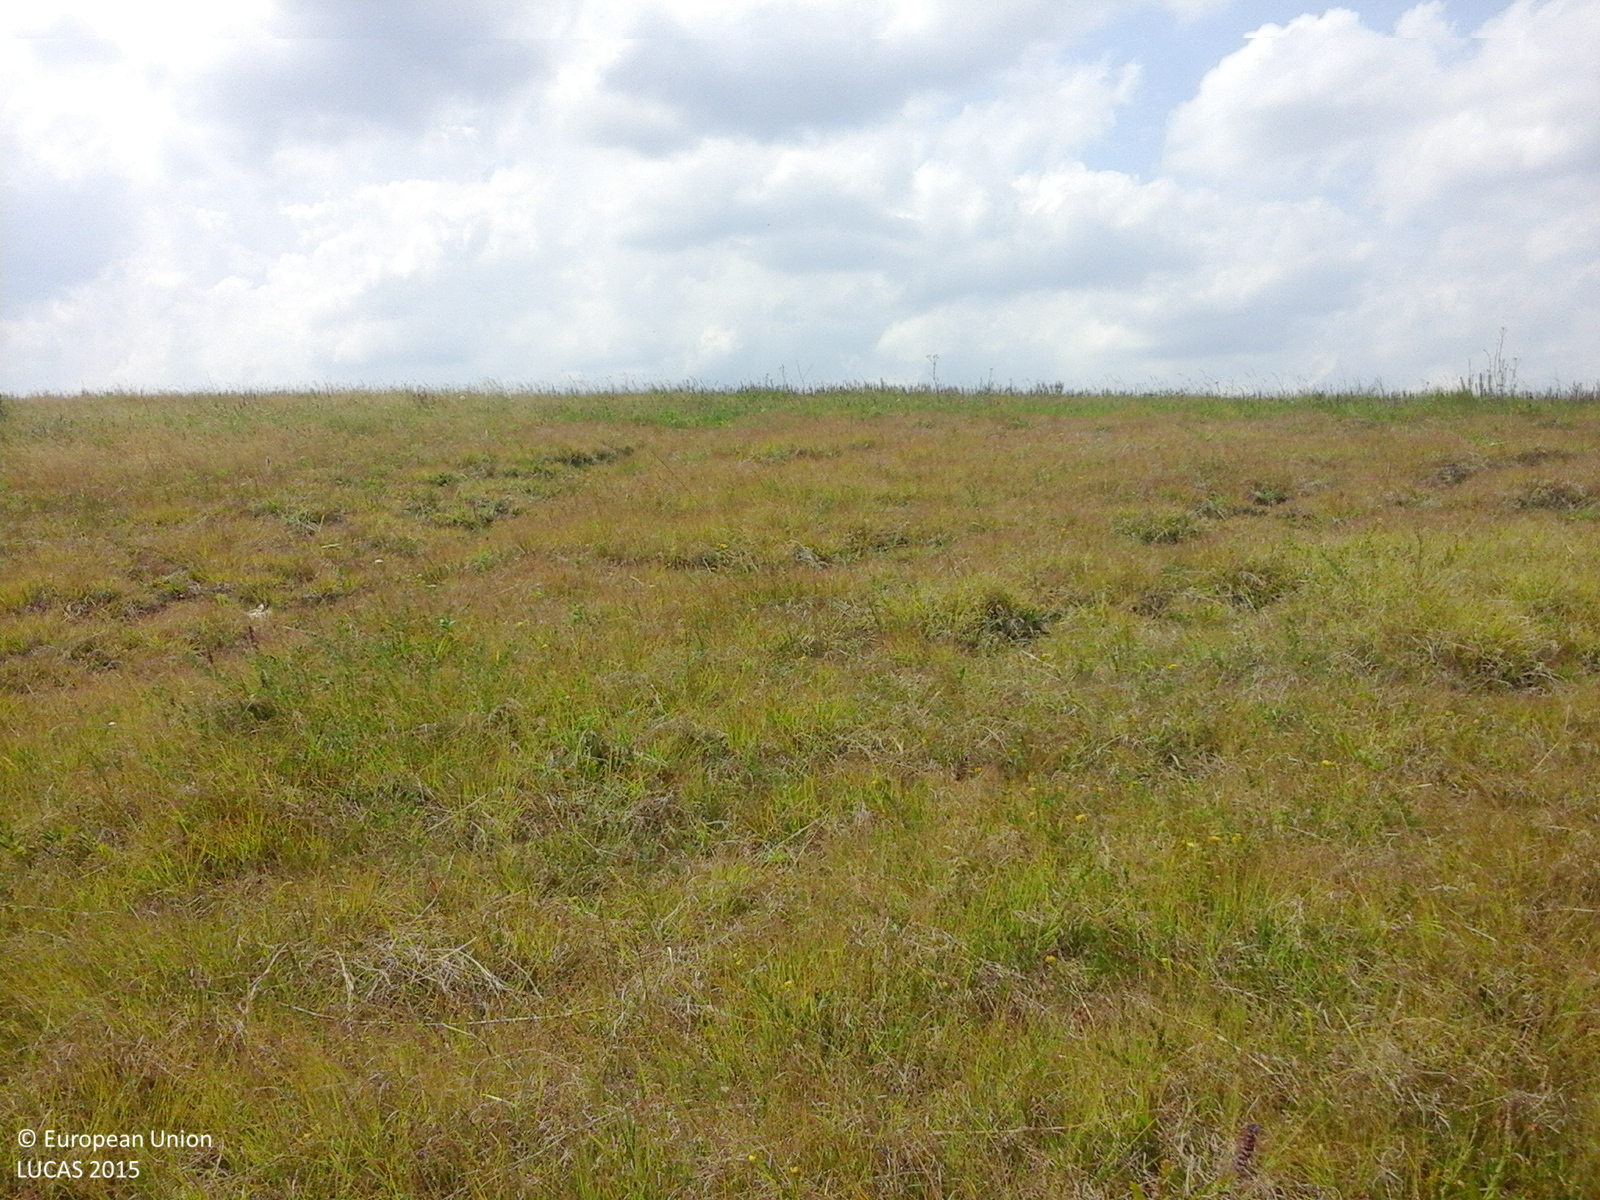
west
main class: Grassland
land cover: Grassland without tree/shrub cover
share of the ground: > 75 %
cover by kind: herbaceous plants 100 %
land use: Agriculture (excluding fallow land and kitchen gardens)
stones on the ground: < 10 %
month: June
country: RO
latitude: 47.4309
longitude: 26.9520
